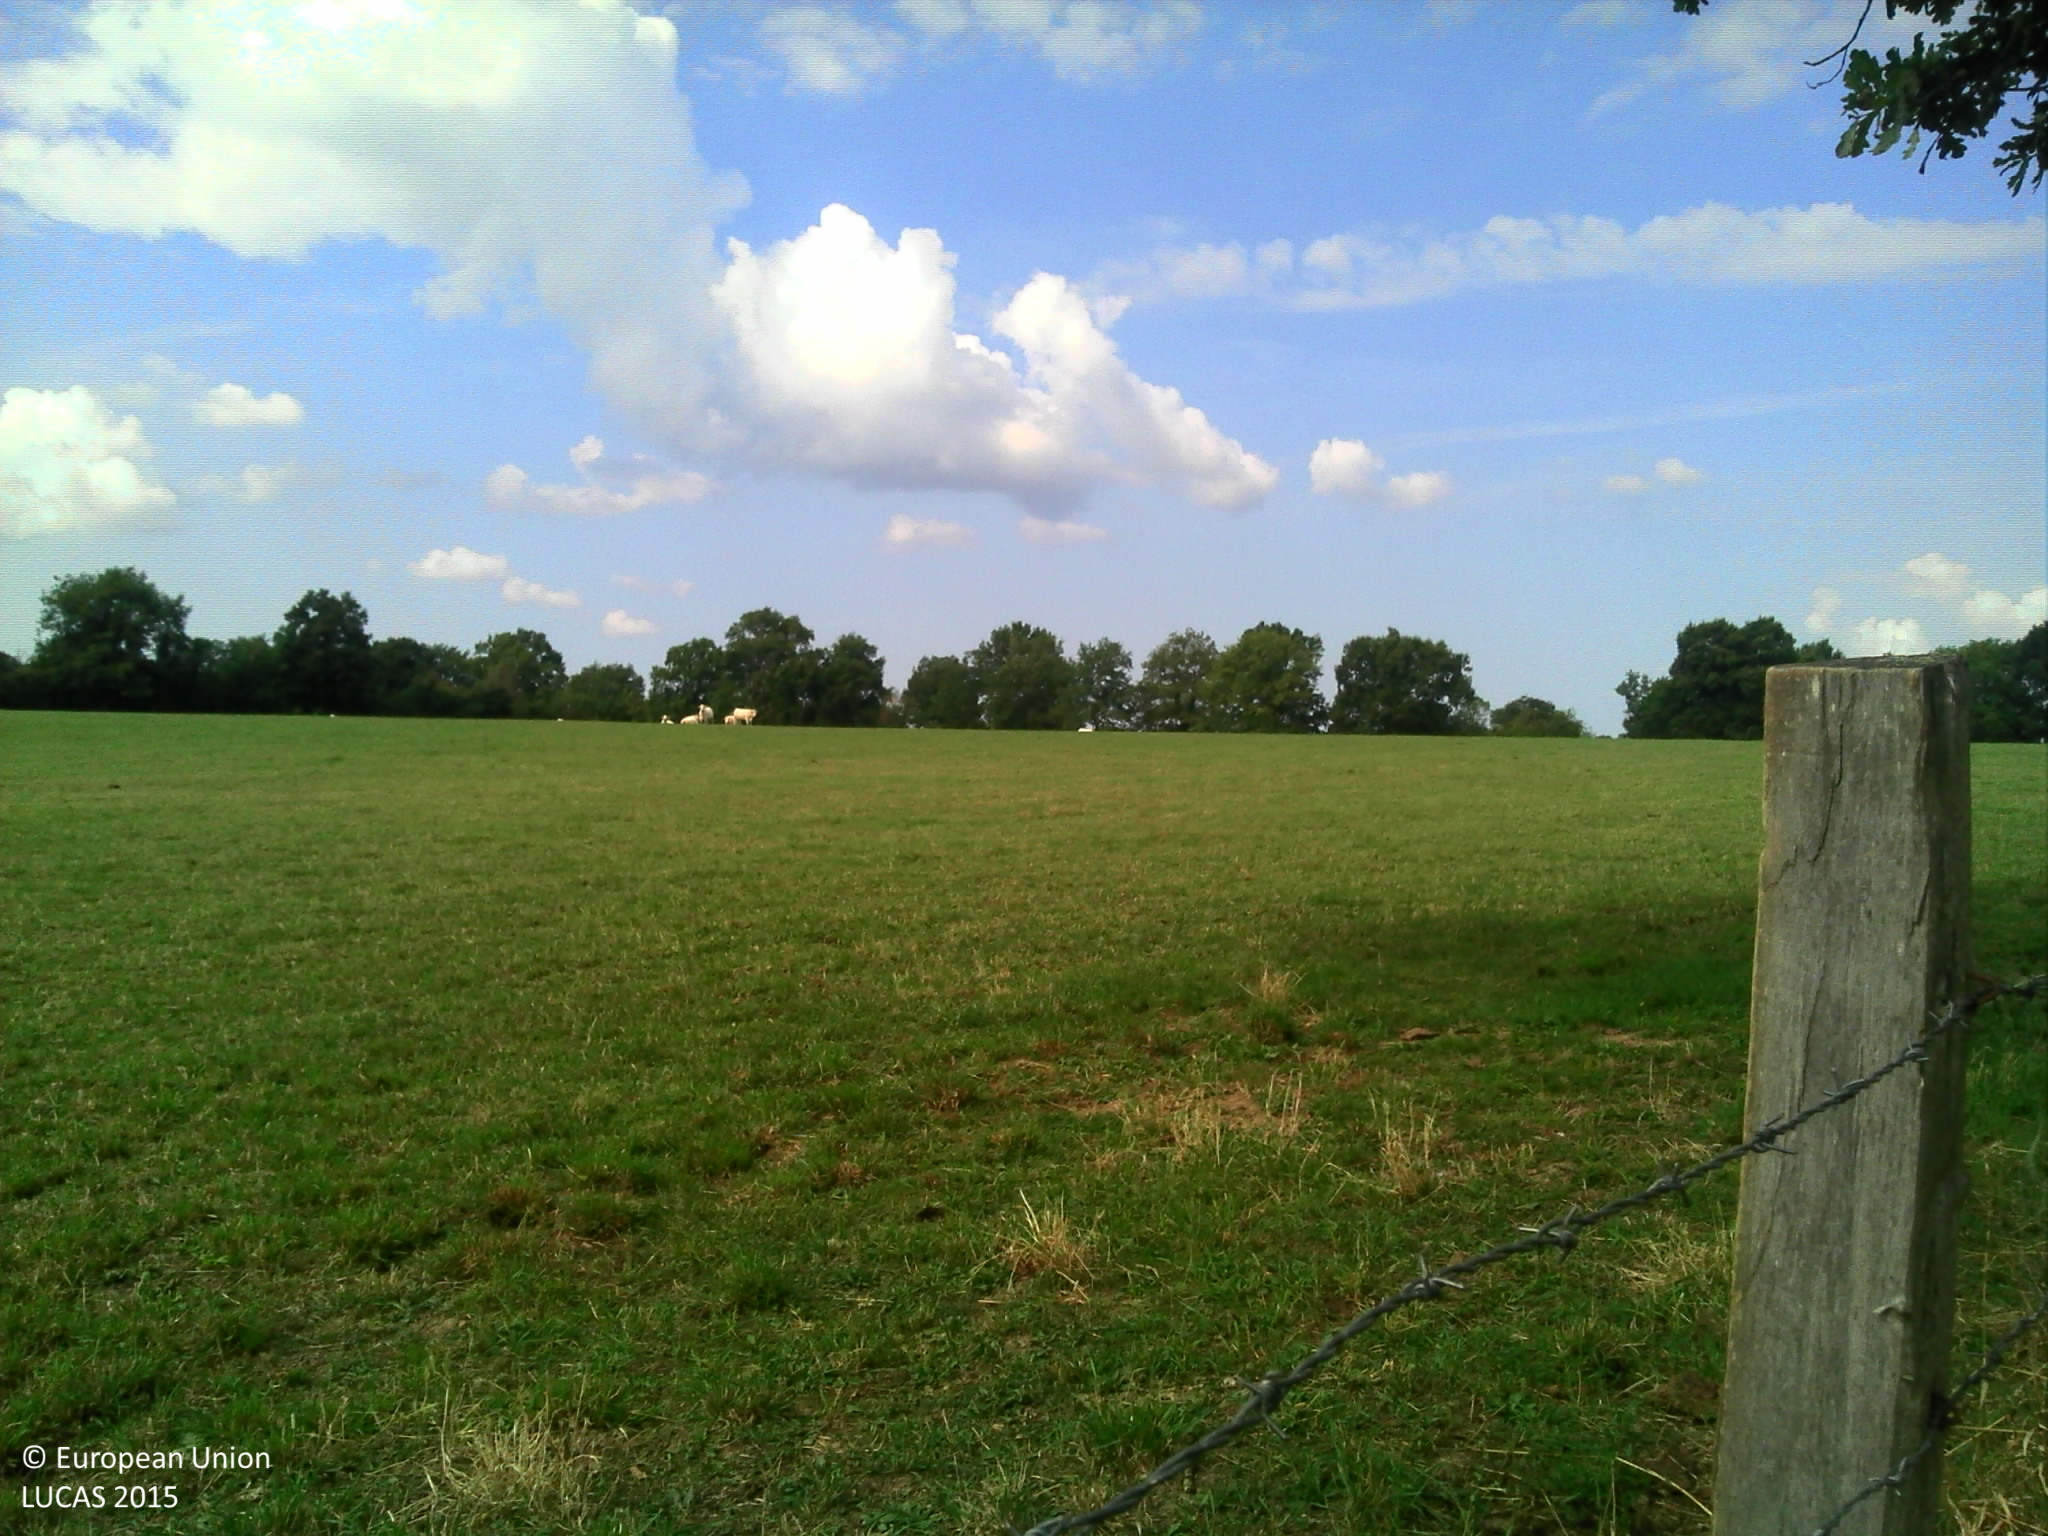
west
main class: Grassland
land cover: Grassland without tree/shrub cover
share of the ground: > 75 %
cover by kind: herbaceous plants 100 %
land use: Agriculture (excluding fallow land and kitchen gardens)
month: August
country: FR
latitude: 46.5163
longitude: 3.2332
